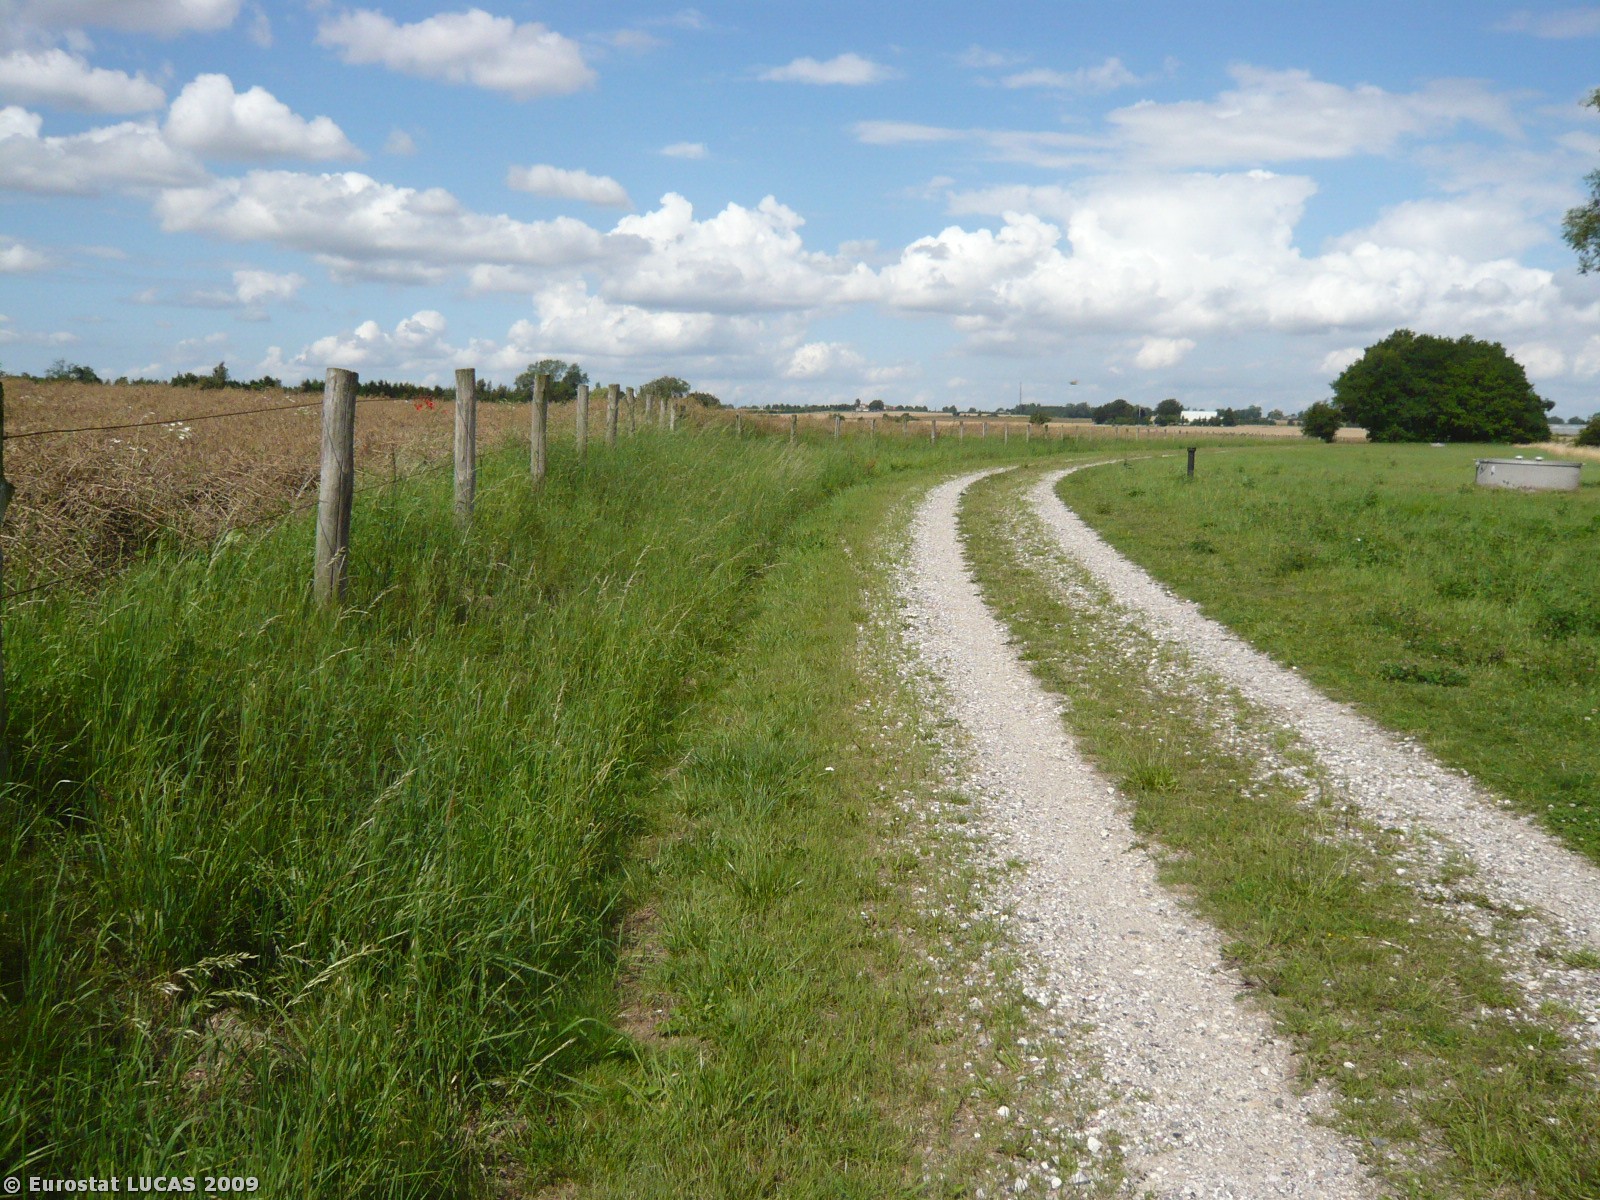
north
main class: Cropland
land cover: Rape and turnip rape
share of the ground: > 75 %
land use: Agriculture (excluding fallow land and kitchen gardens)
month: July
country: DK
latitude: 55.5406
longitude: 12.1376
